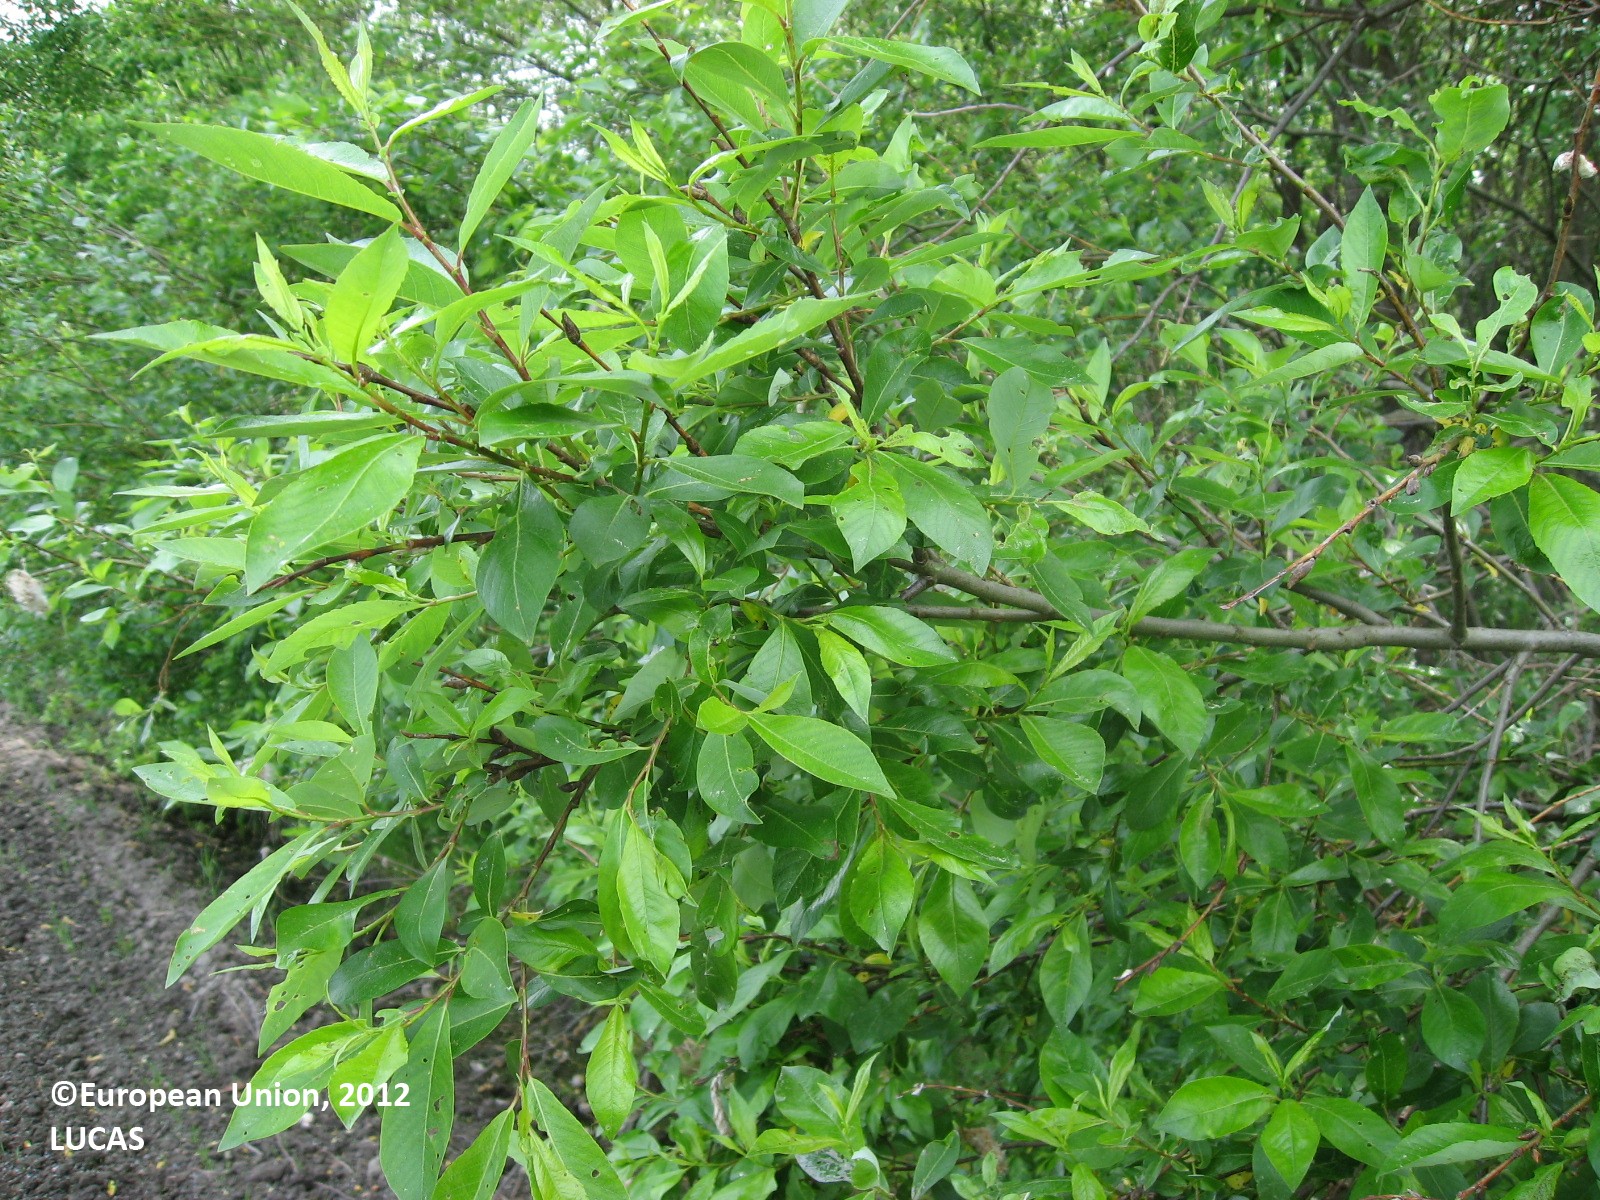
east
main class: Cropland
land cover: Common wheat
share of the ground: < 10 %
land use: Agriculture (excluding fallow land and kitchen gardens)
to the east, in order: Common wheat; Broadleaved woodland; Grass margins; Common wheat; Grassland without tree/shrub cover; Ditches and canals; Grassland with sparse tree/shrub cover; Broadleaved woodland; Ditches and canals; Broadleaved woodland; Ditches and canals; Grass margins; Artificial constructions in urban areas
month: June
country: FI
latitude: 60.3852
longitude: 24.9755
